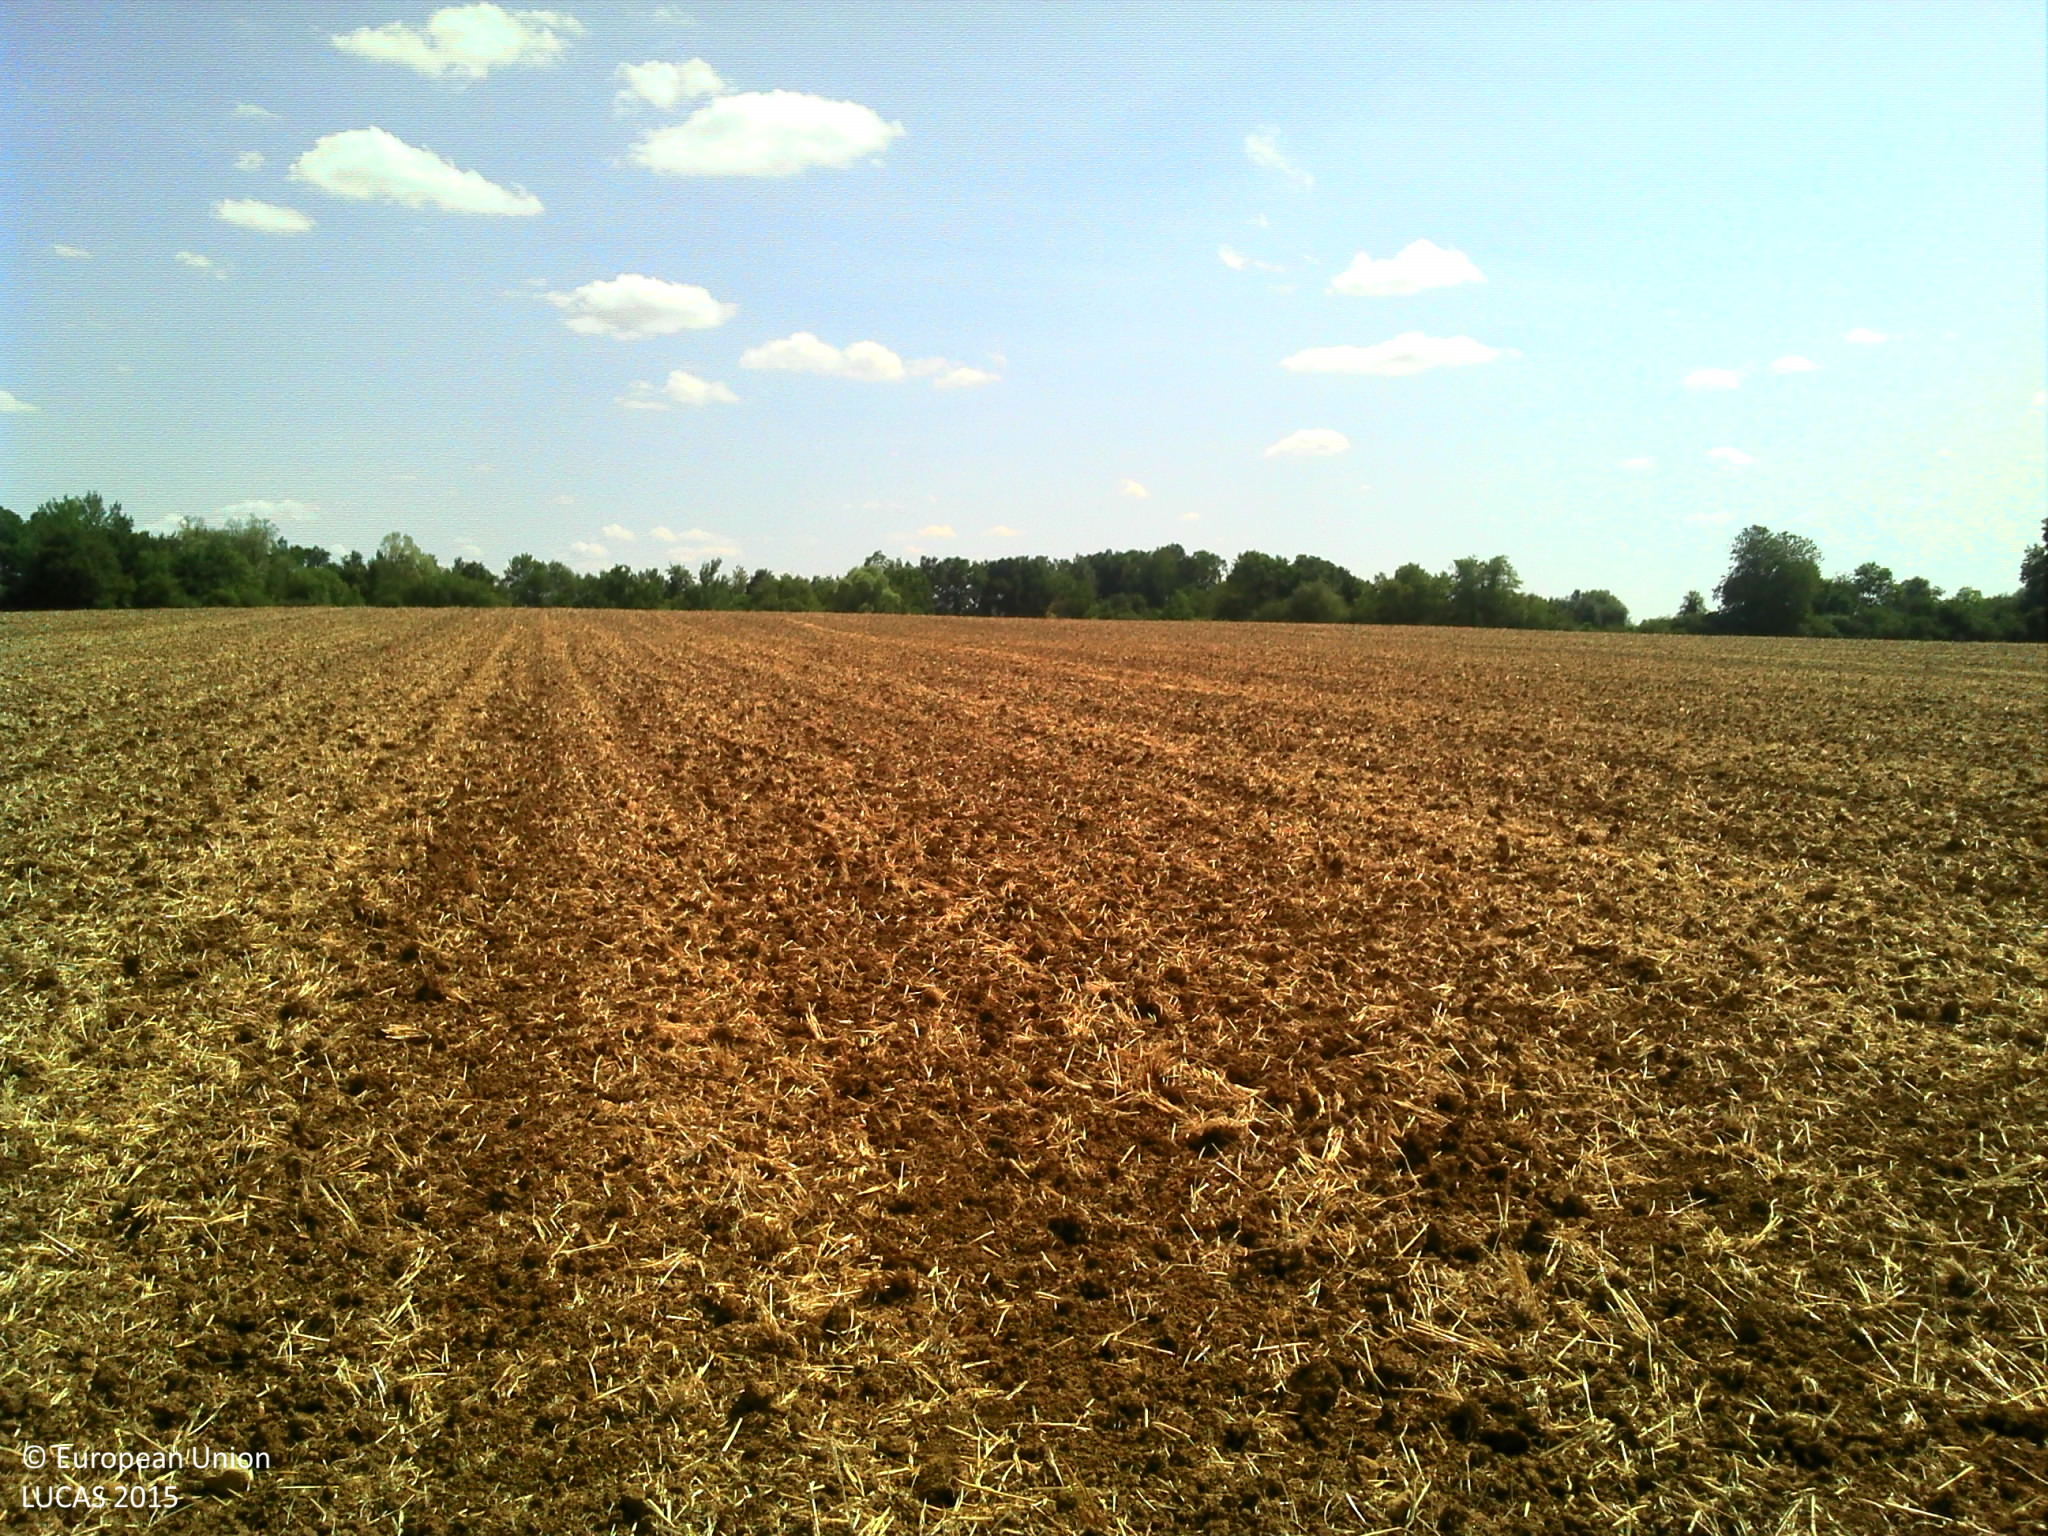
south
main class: Cropland
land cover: Barley
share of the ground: < 10 %
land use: Agriculture (excluding fallow land and kitchen gardens)
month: July
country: FR
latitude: 48.0917
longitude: 4.9910
